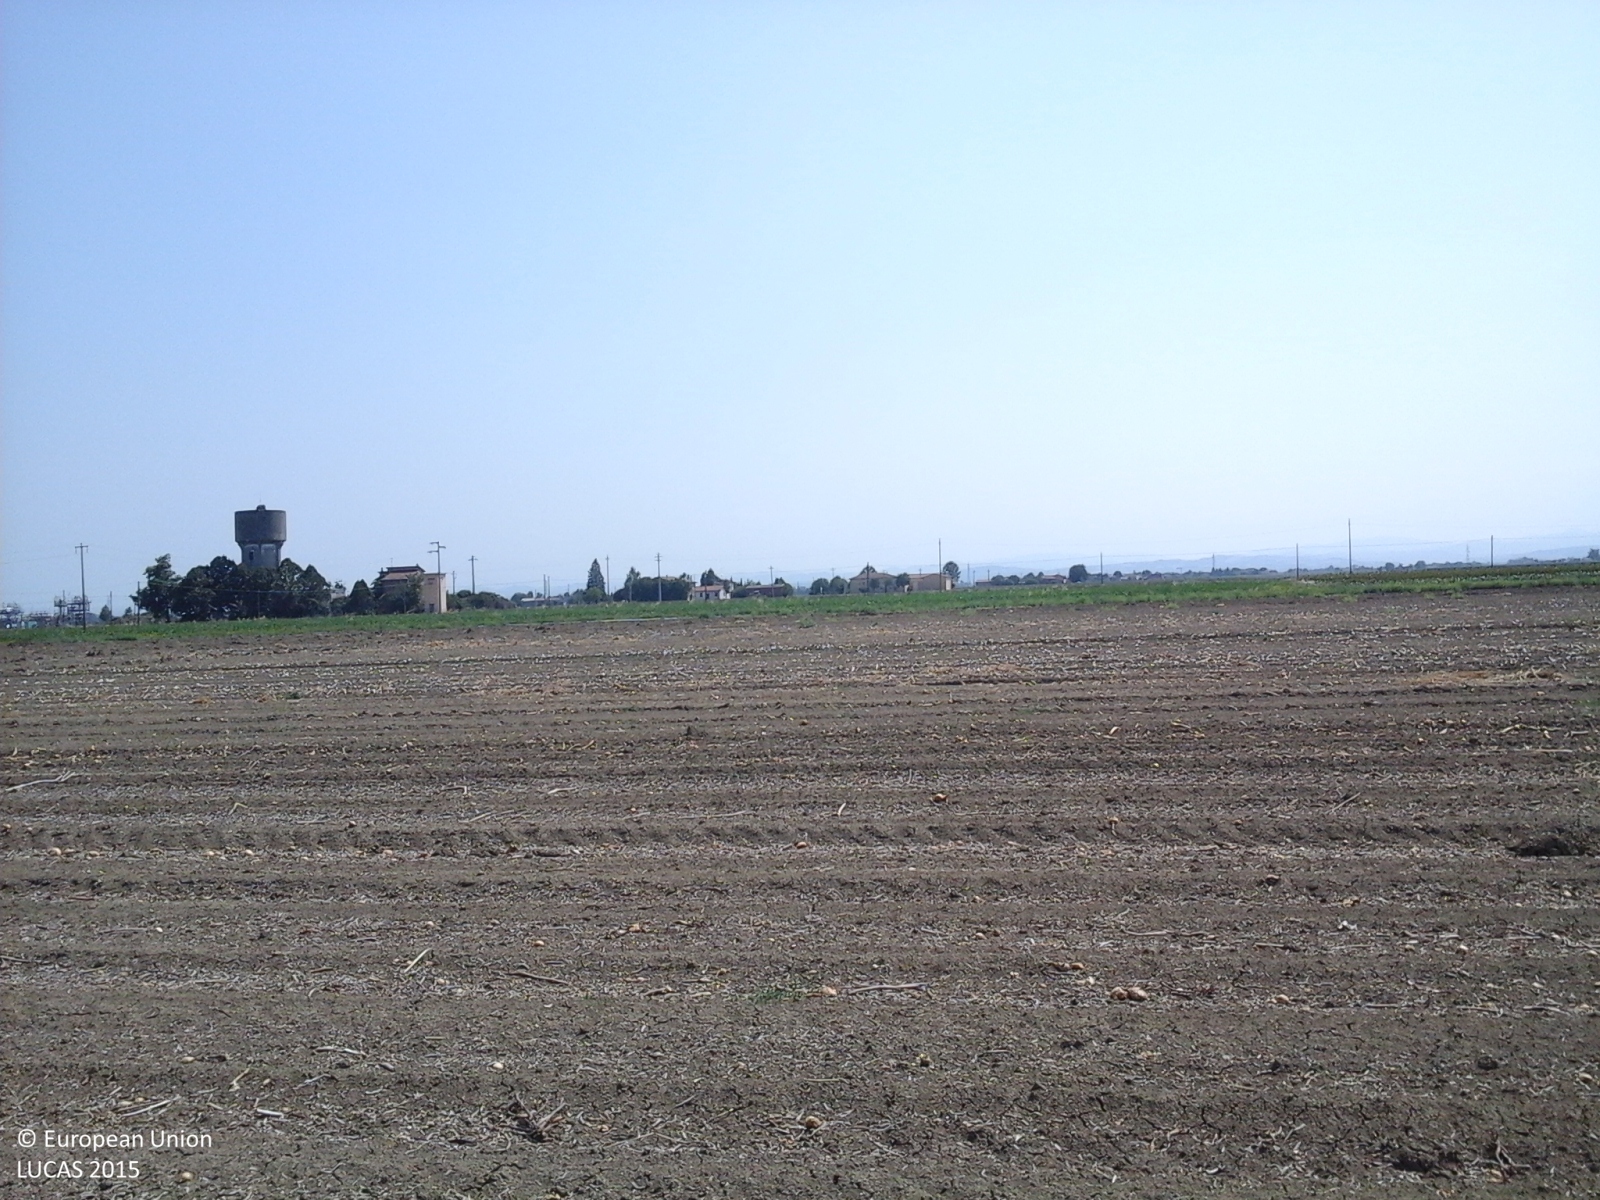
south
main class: Cropland
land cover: Other root crops
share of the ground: > 75 %
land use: Agriculture (excluding fallow land and kitchen gardens)
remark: Harvested field
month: July
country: IT
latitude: 44.4991
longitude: 11.6942
